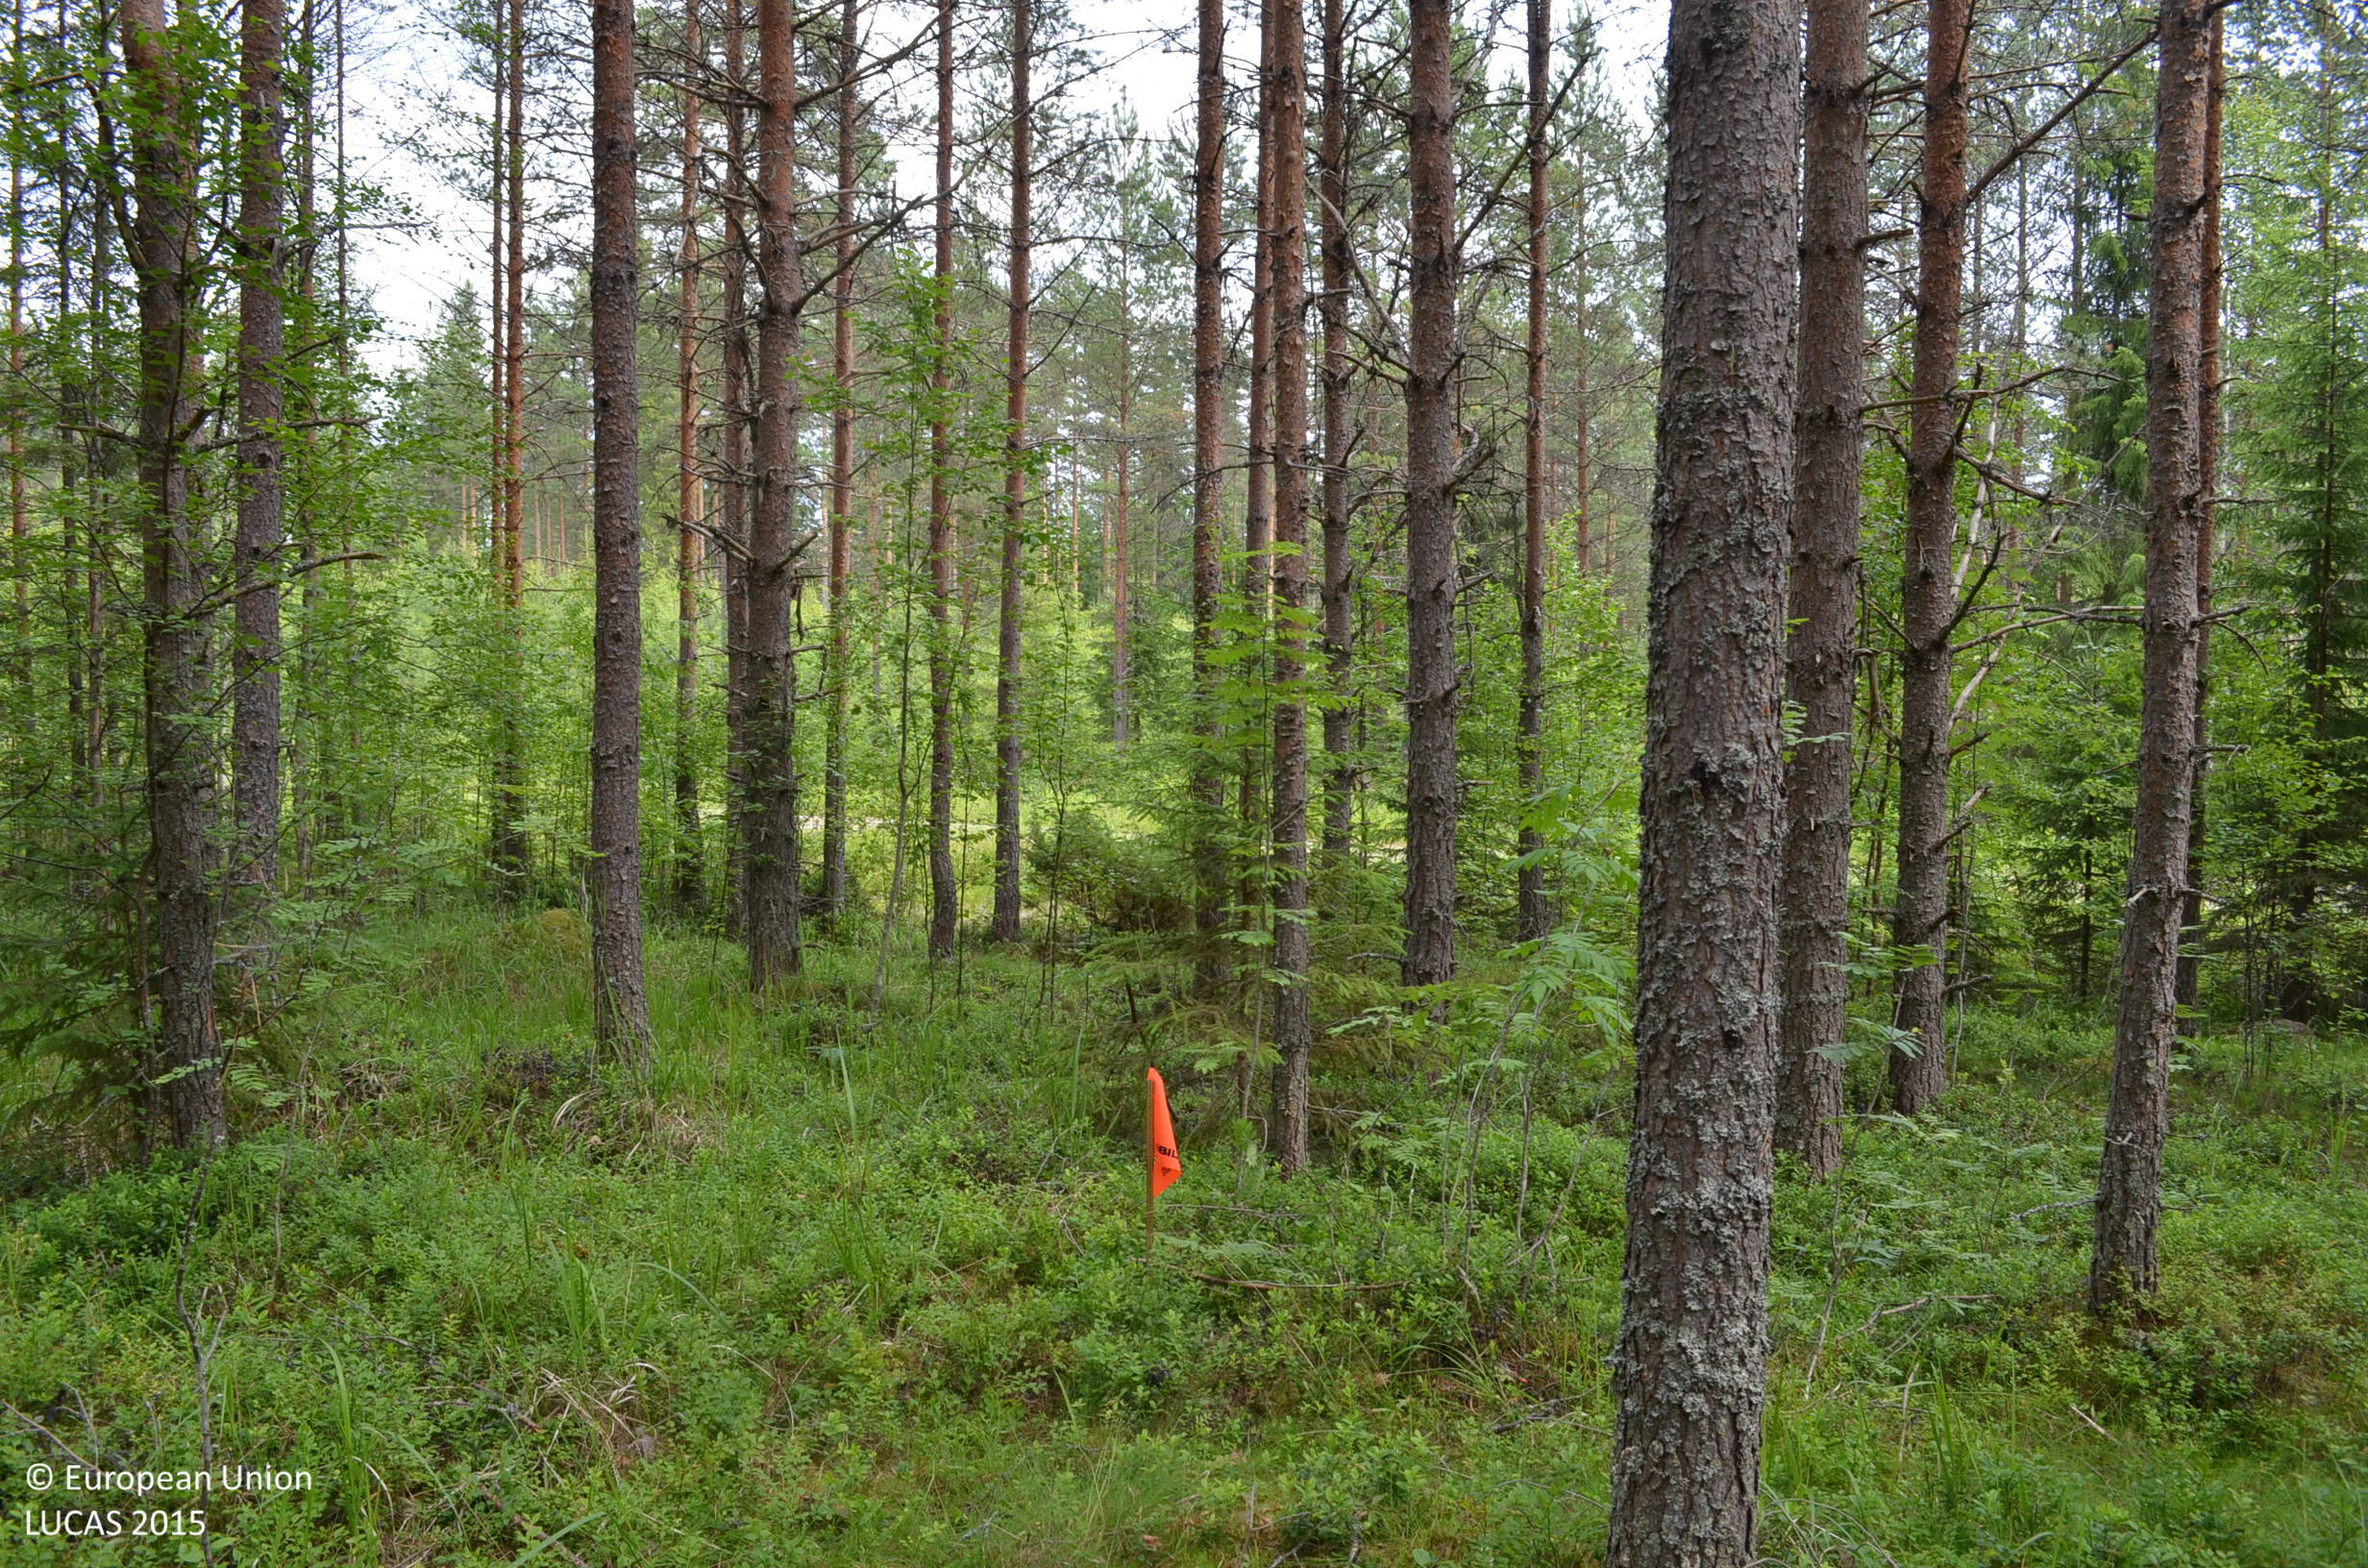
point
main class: Woodland
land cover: Pine dominated coniferous woodland
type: boreal forest
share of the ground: > 75 %
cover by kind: coniferous forest trees 75 %, shrubs 20 %, broadleaved forest trees 5 %
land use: Forestry
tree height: > 5 m
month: July
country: FI
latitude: 62.1806
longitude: 23.5390
